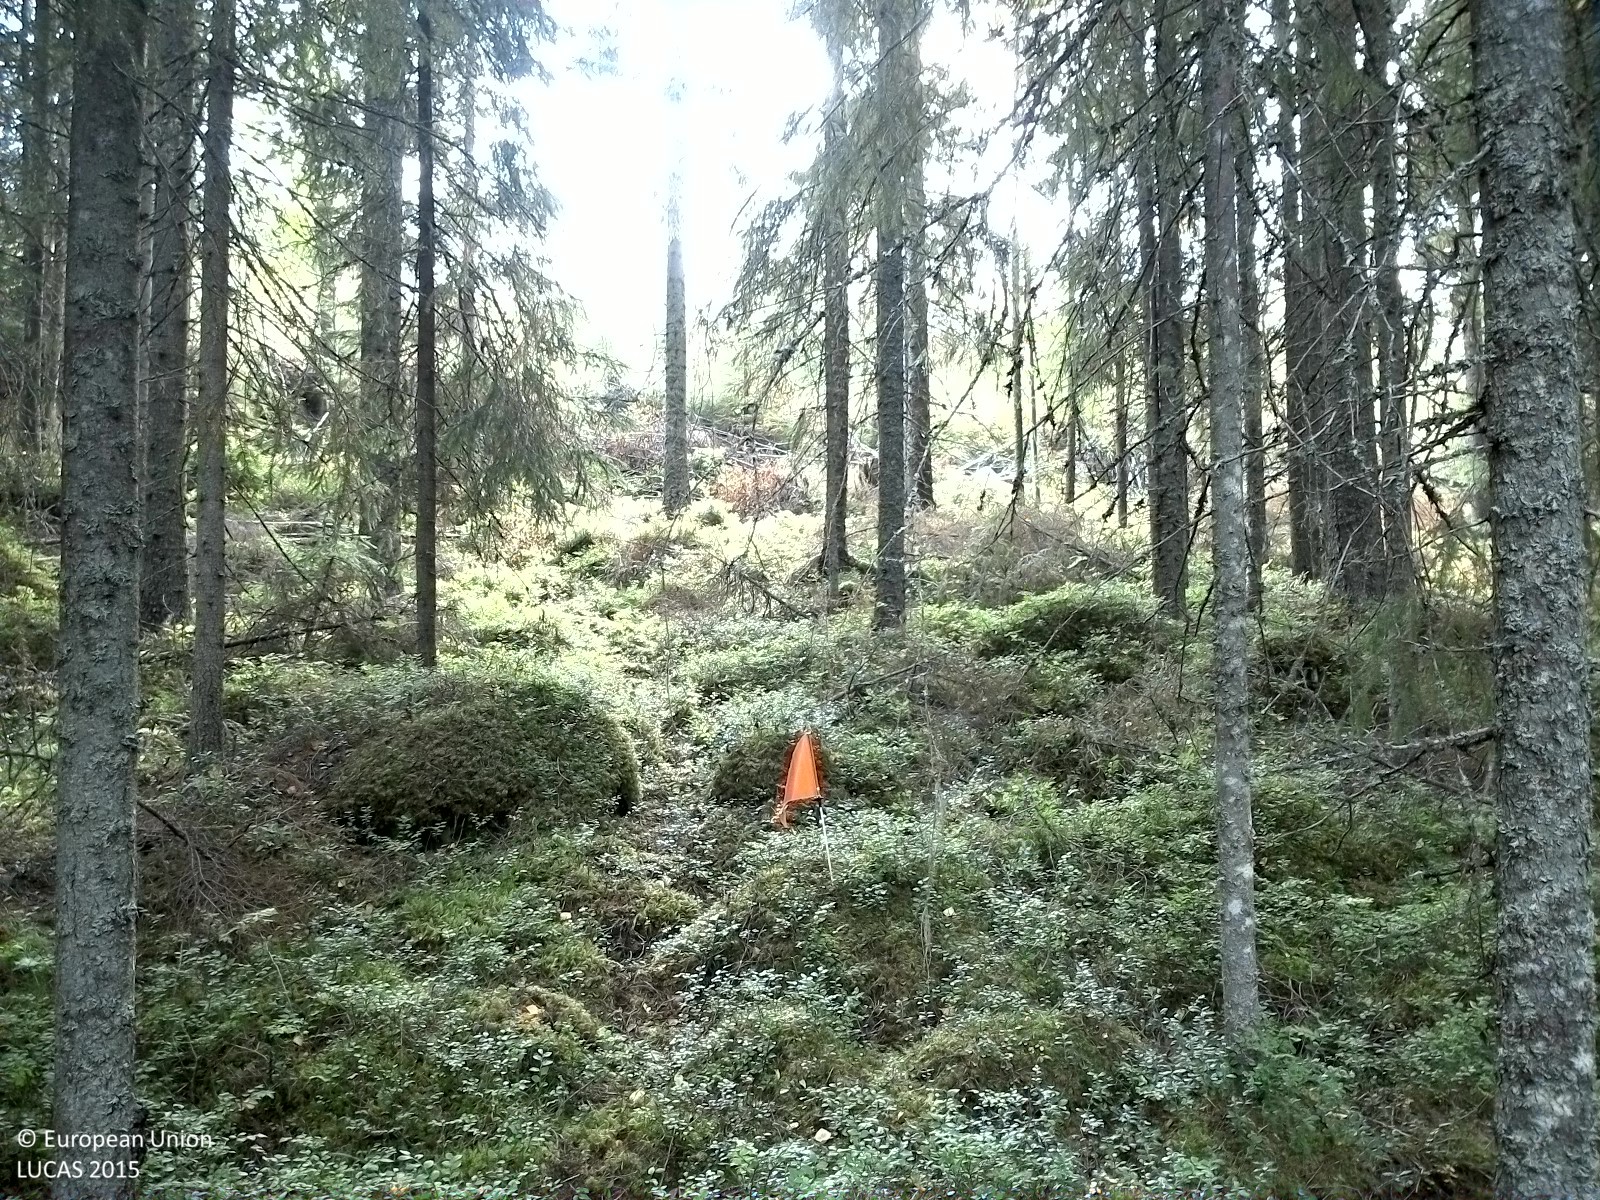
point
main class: Woodland
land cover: Spruce dominated coniferous woodland
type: boreal forest
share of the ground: 50 - 75 %
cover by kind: coniferous forest trees 60 %, shrubs 20 %, lichens and mosses 20 %
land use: Forestry
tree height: > 5 m
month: September
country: SE
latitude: 62.5268
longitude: 16.4881
